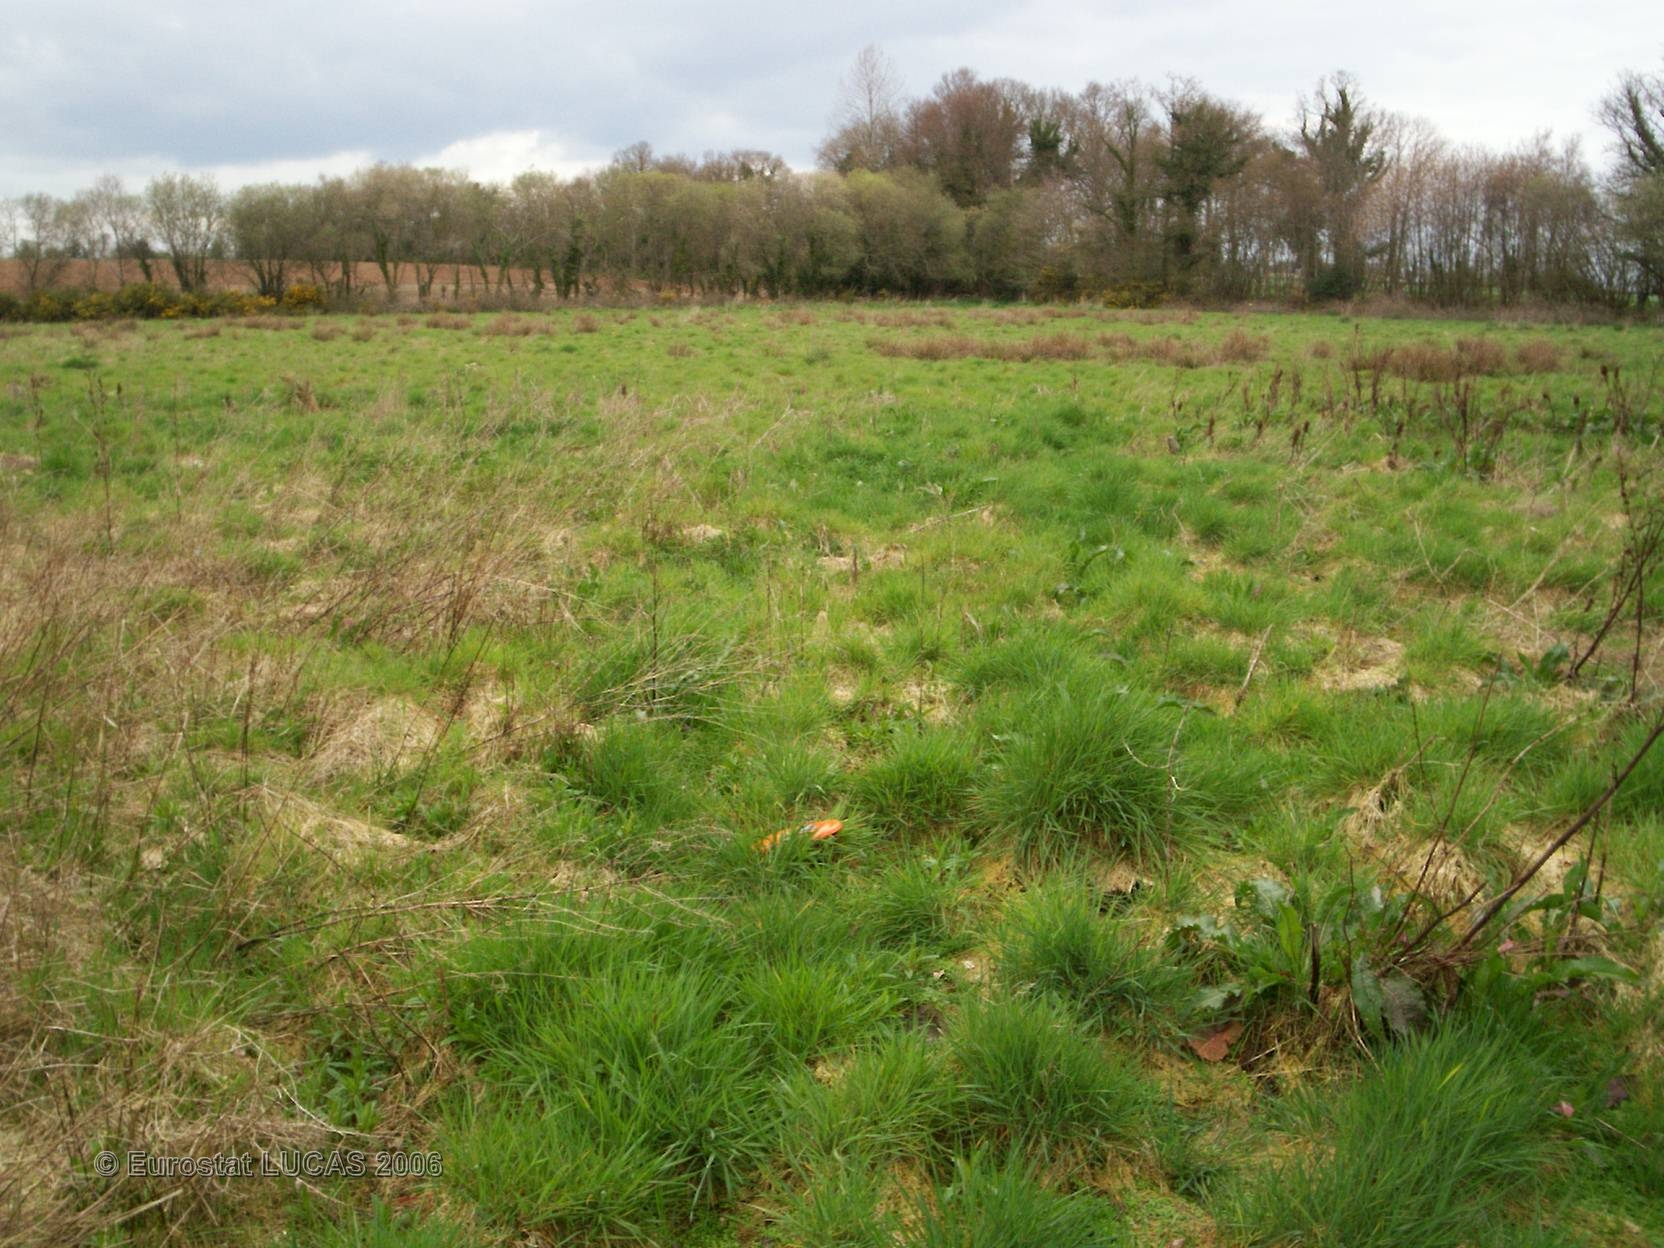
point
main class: Grassland
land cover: Grassland without tree/shrub cover
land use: Fallow land
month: April
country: FR
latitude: 48.1360
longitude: -2.8999
